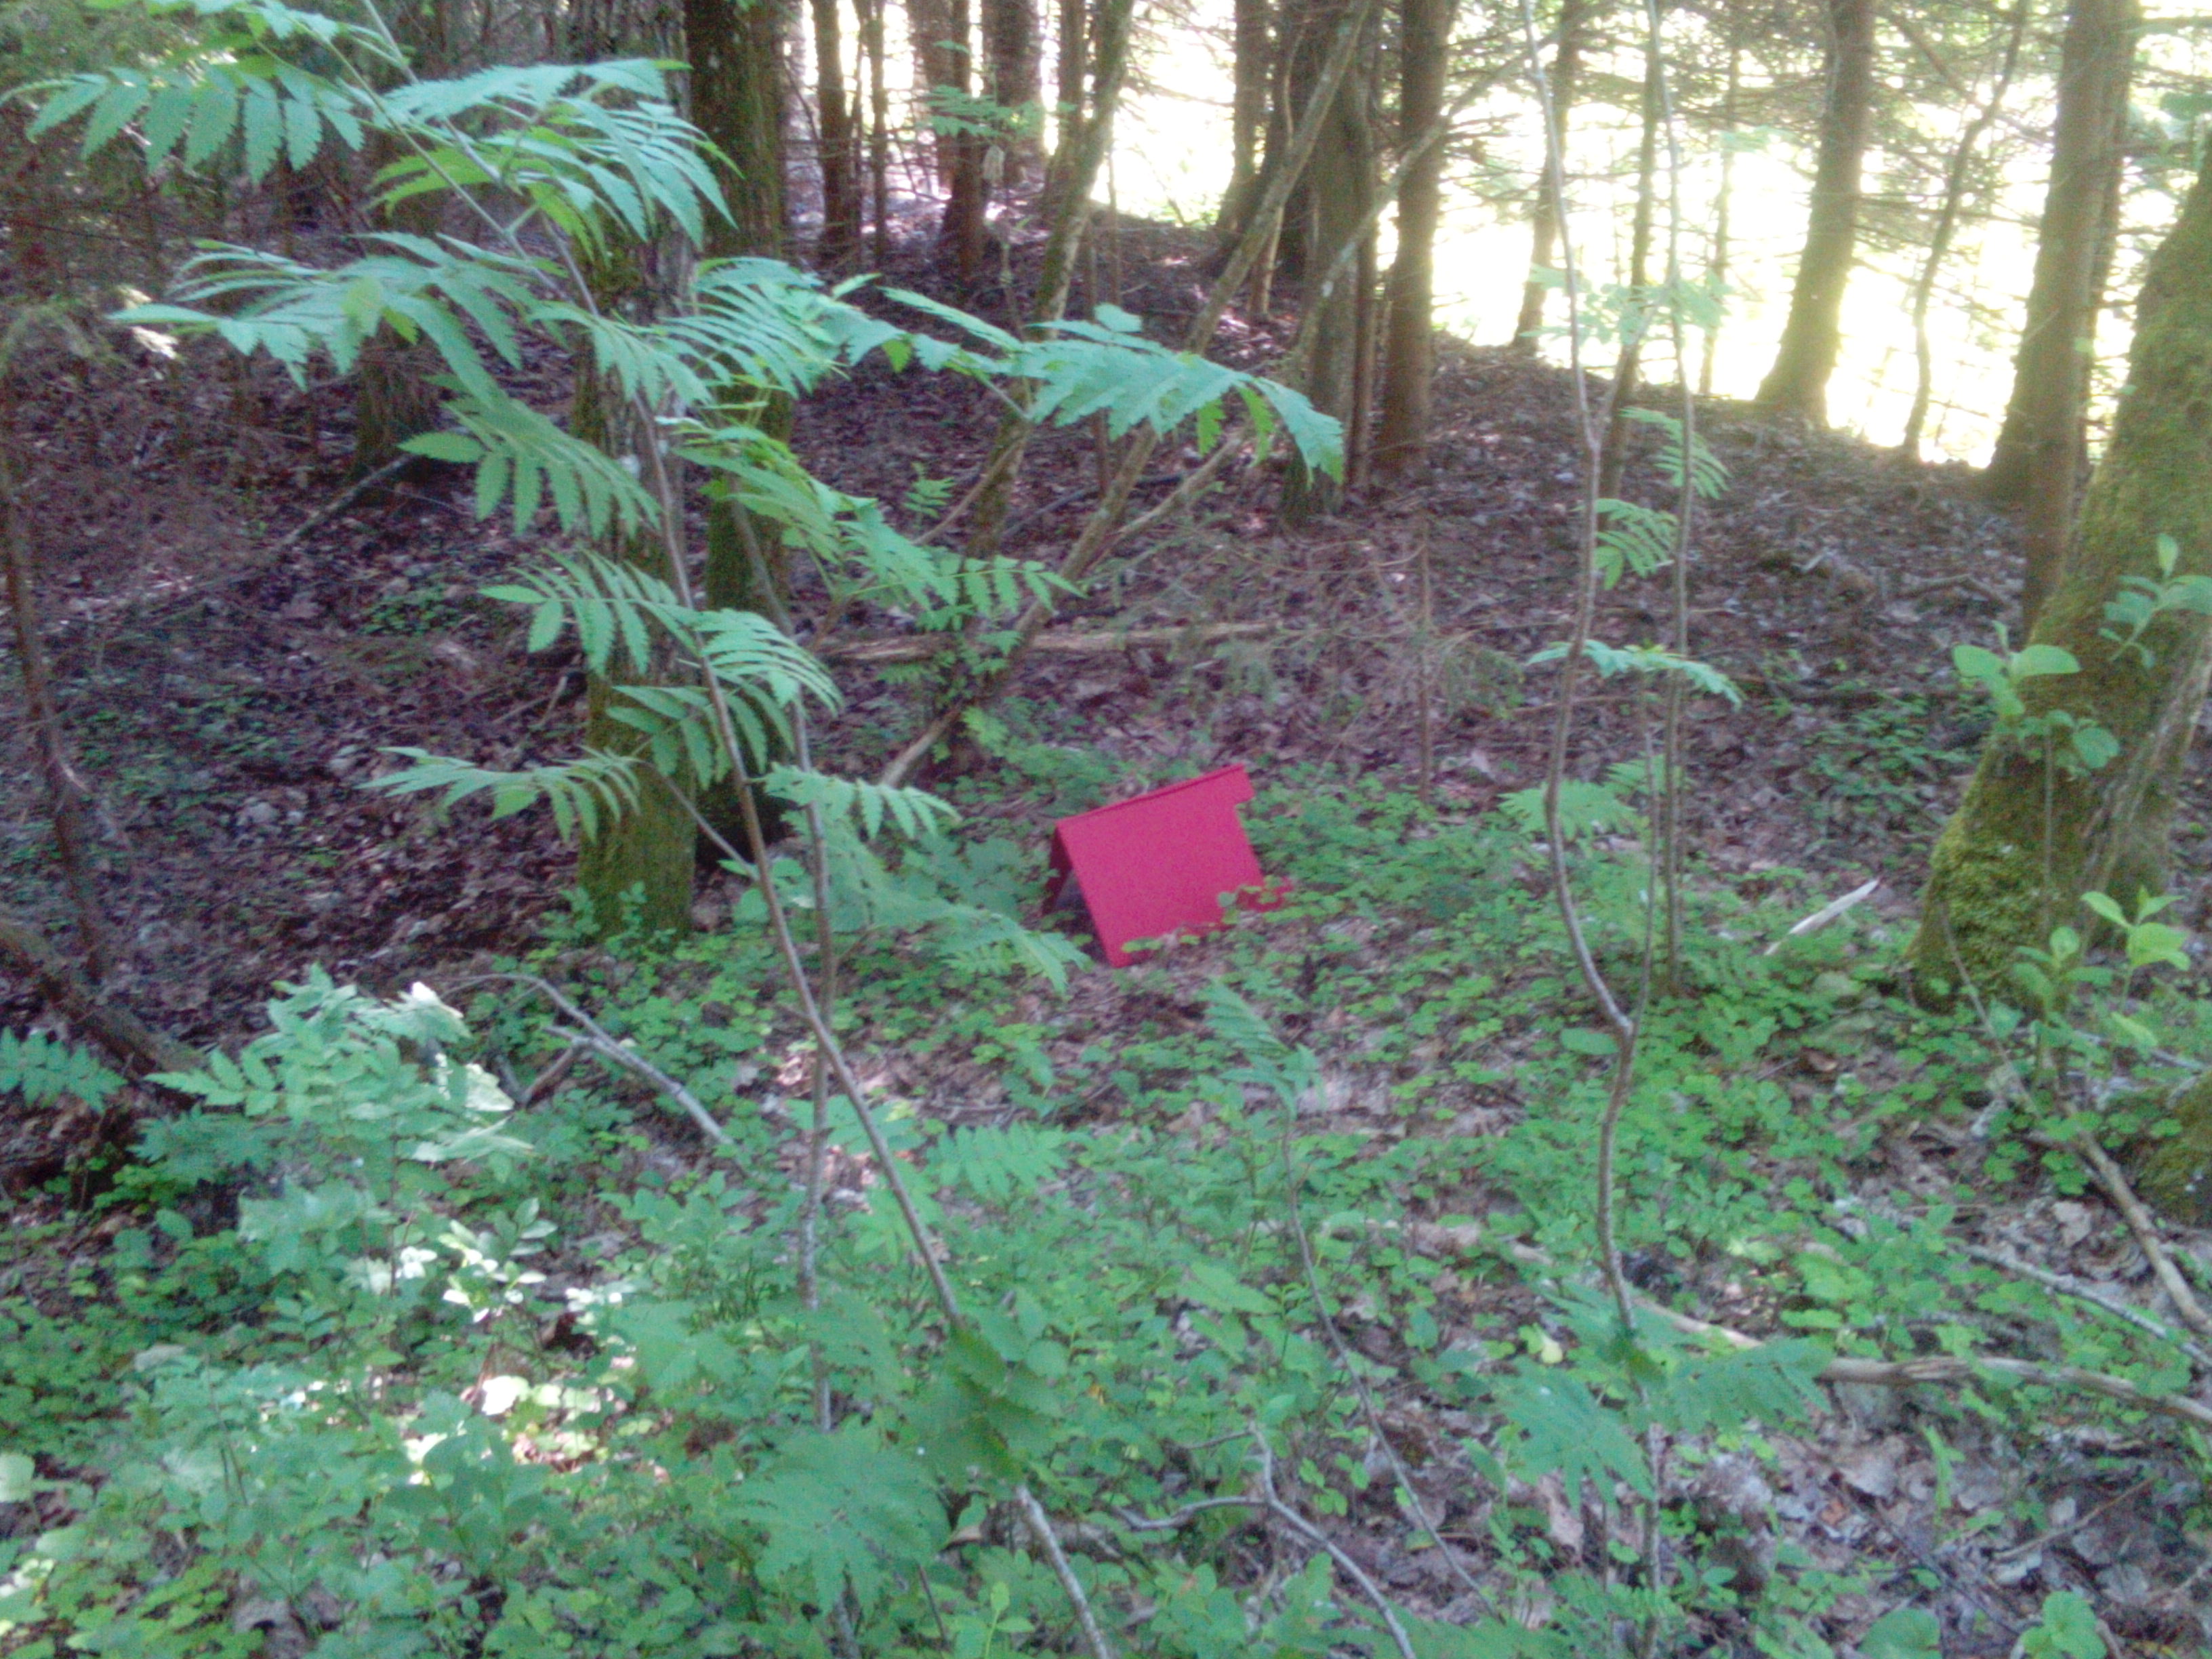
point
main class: Woodland
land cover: Spruce dominated mixed woodland
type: hemiboreal forest and nemoral coniferous forest and mixed broadleaved-coniferous forest
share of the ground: > 75 %
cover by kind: broadleaved forest trees 55 %, coniferous forest trees 40 %, shrubs 5 %
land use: Forestry
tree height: > 5 m
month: June
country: LV
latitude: 56.6710
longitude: 21.8781
